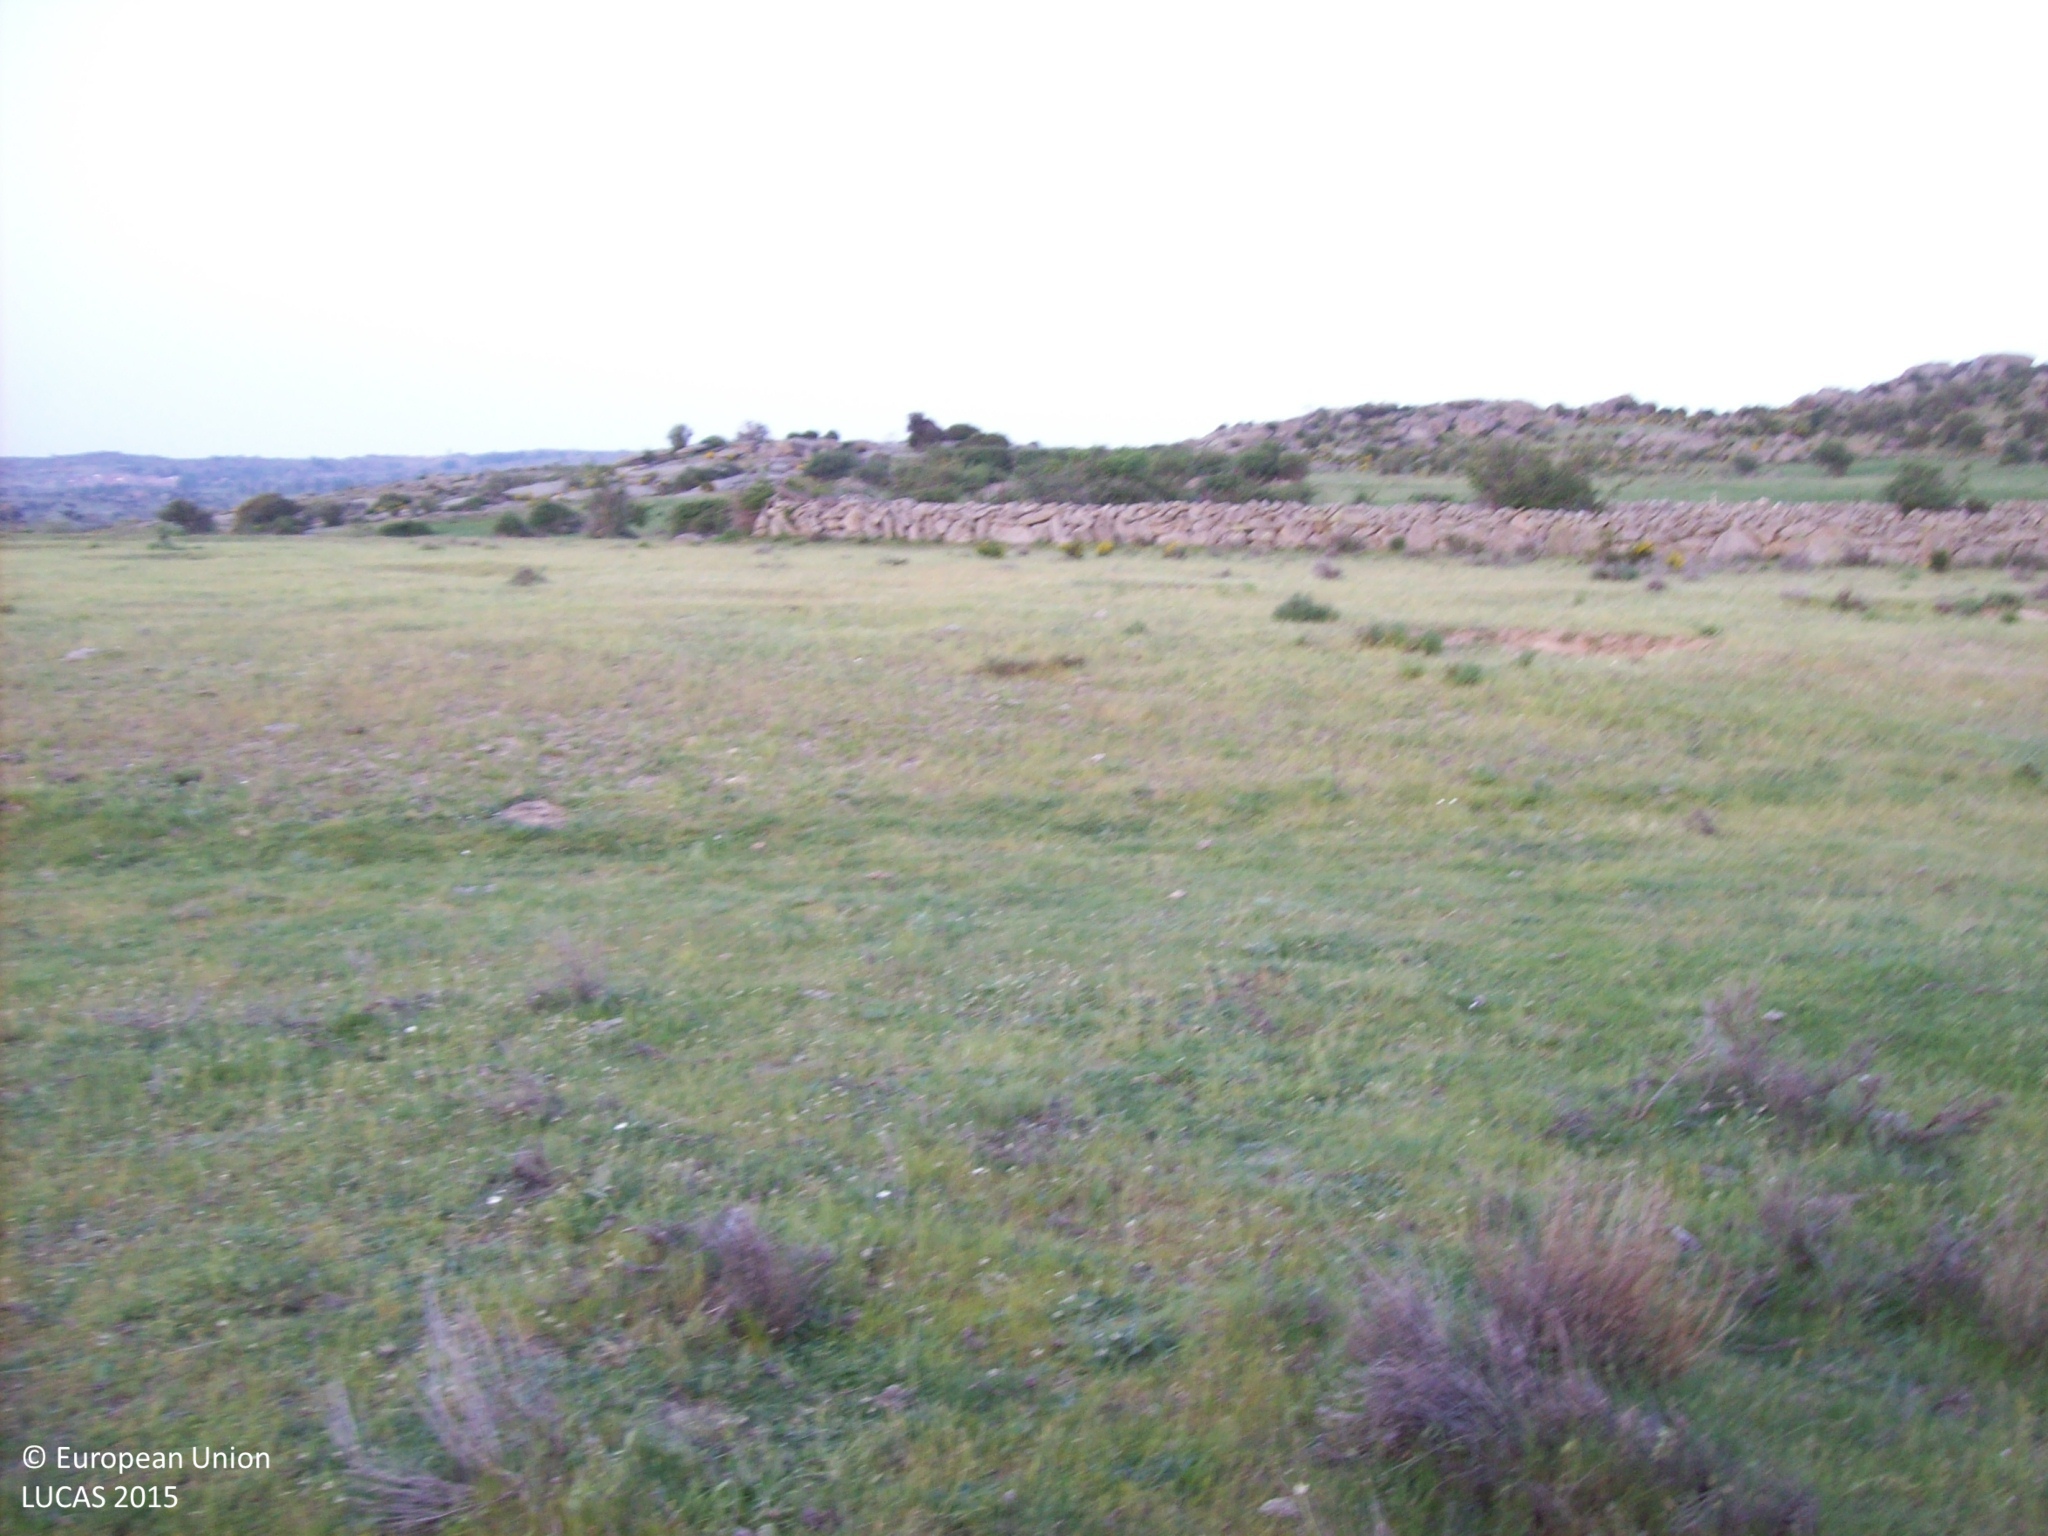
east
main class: Shrubland
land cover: Shrubland without tree cover
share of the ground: 25 - 50 %
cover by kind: herbaceous plants 65 %, shrubs 30 %, consolidated bare surface 5 %
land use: Agriculture (excluding fallow land and kitchen gardens)
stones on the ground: < 10 %
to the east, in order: Shrubland without tree cover; Grassland without tree/shrub cover; Dry stone walls; Grassland without tree/shrub cover; Abandoned hedges; Dry stone walls; Grassland without tree/shrub cover; Single bushes/trees; Shrubland without tree cover; Grassland without tree/shrub cover; Dry stone walls; Abandoned hedges; Grassland without tree/shrub cover; Abandoned hedges; Dry stone walls; Grassland without tree/shrub cover; Shrubland without tree cover
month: May
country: ES
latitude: 40.6921
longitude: -4.9589
